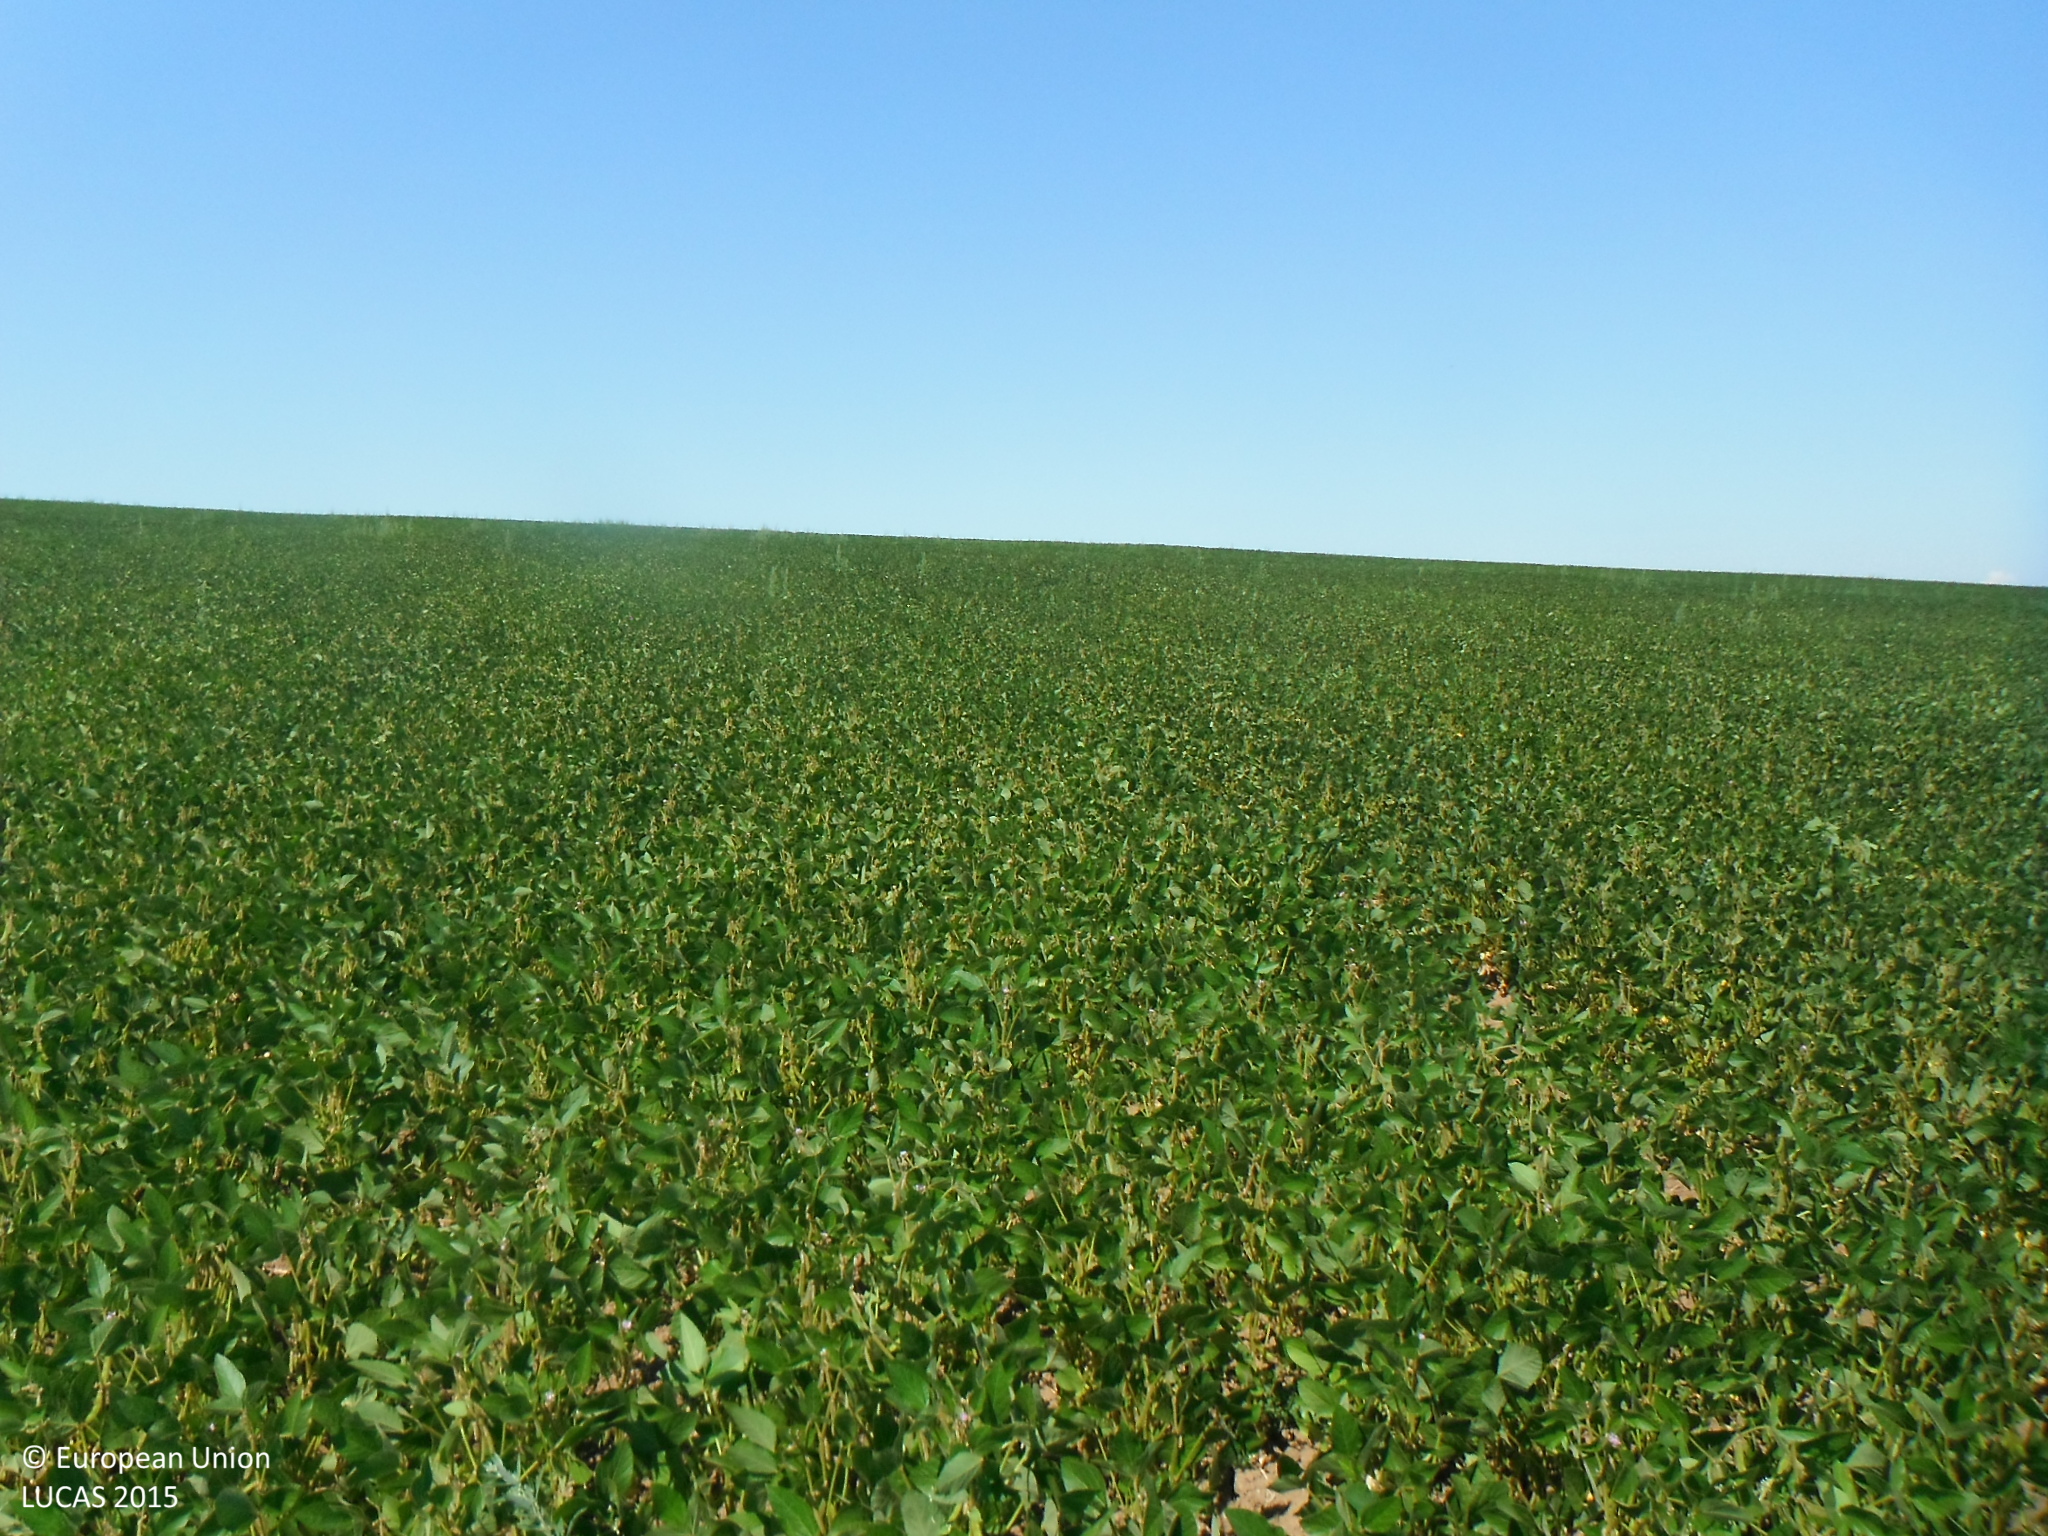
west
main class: Cropland
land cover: Soya
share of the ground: > 75 %
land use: Agriculture (excluding fallow land and kitchen gardens)
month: July
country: SK
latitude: 48.7124
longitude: 17.1716
